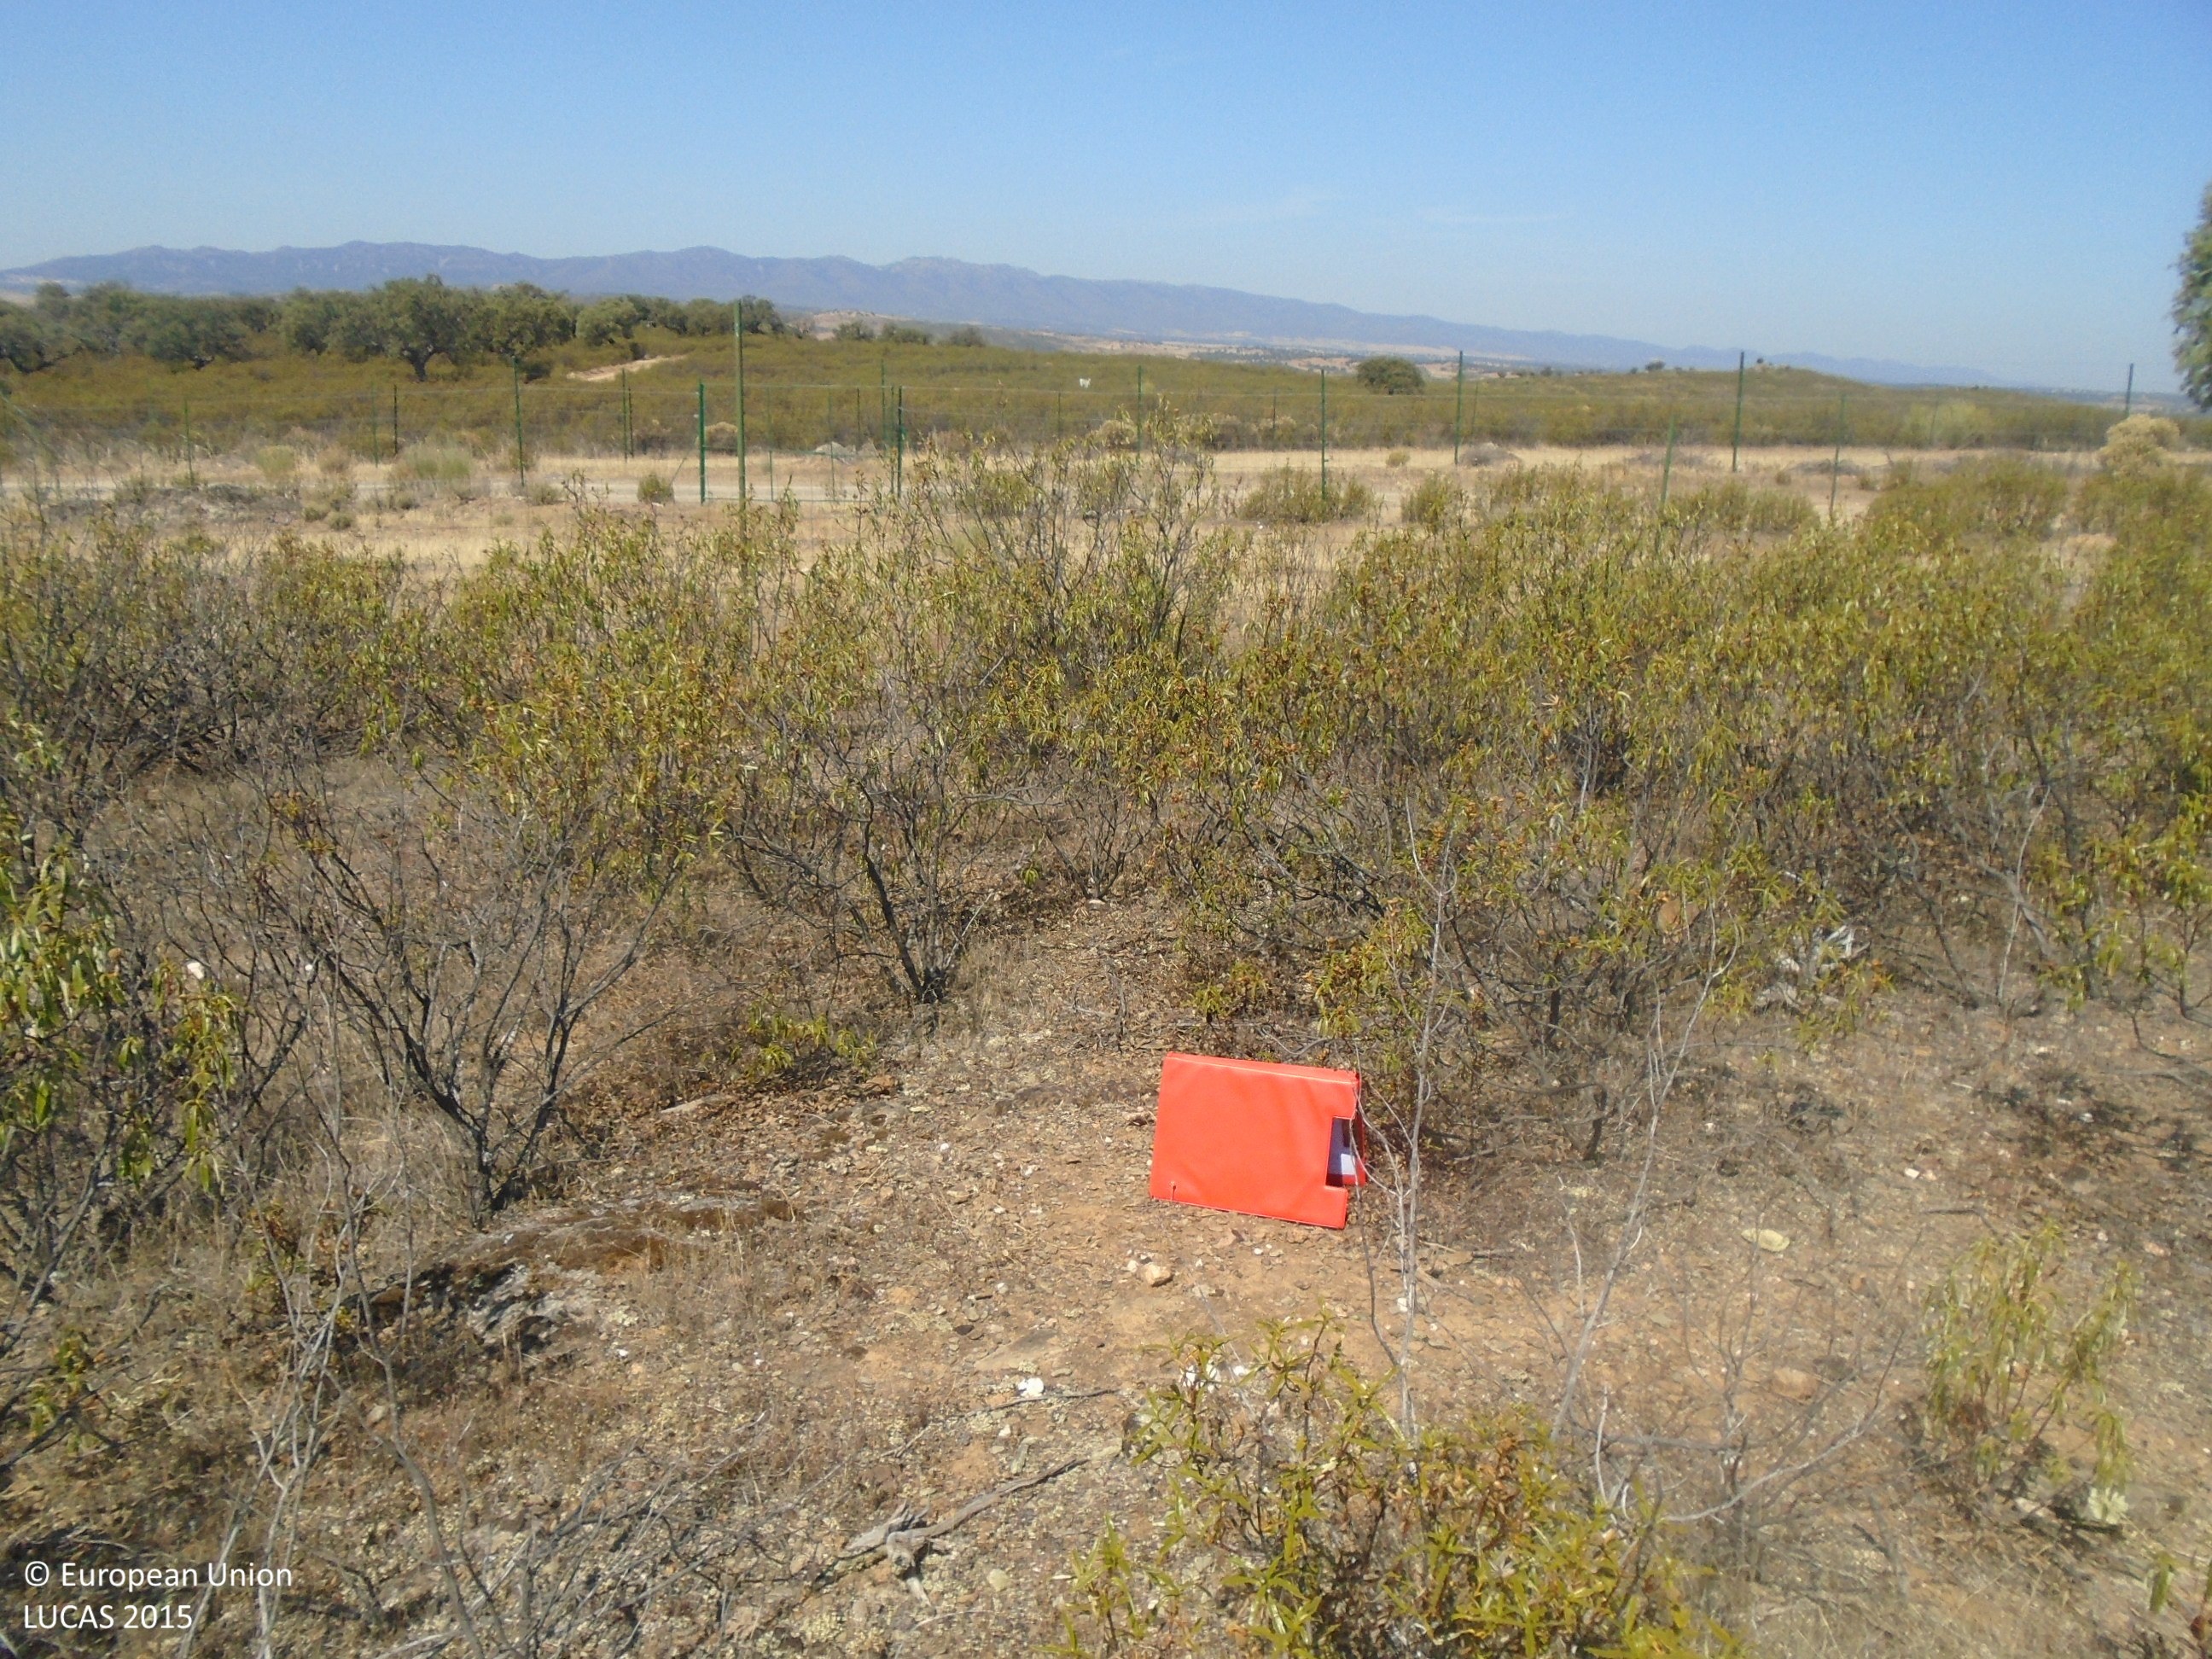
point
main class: Shrubland
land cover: Shrubland without tree cover
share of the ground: > 75 %
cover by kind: shrubs 95 %, consolidated bare surface 5 %
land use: Semi-natural and natural areas not in use
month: July
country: ES
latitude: 39.6047
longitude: -4.9873
